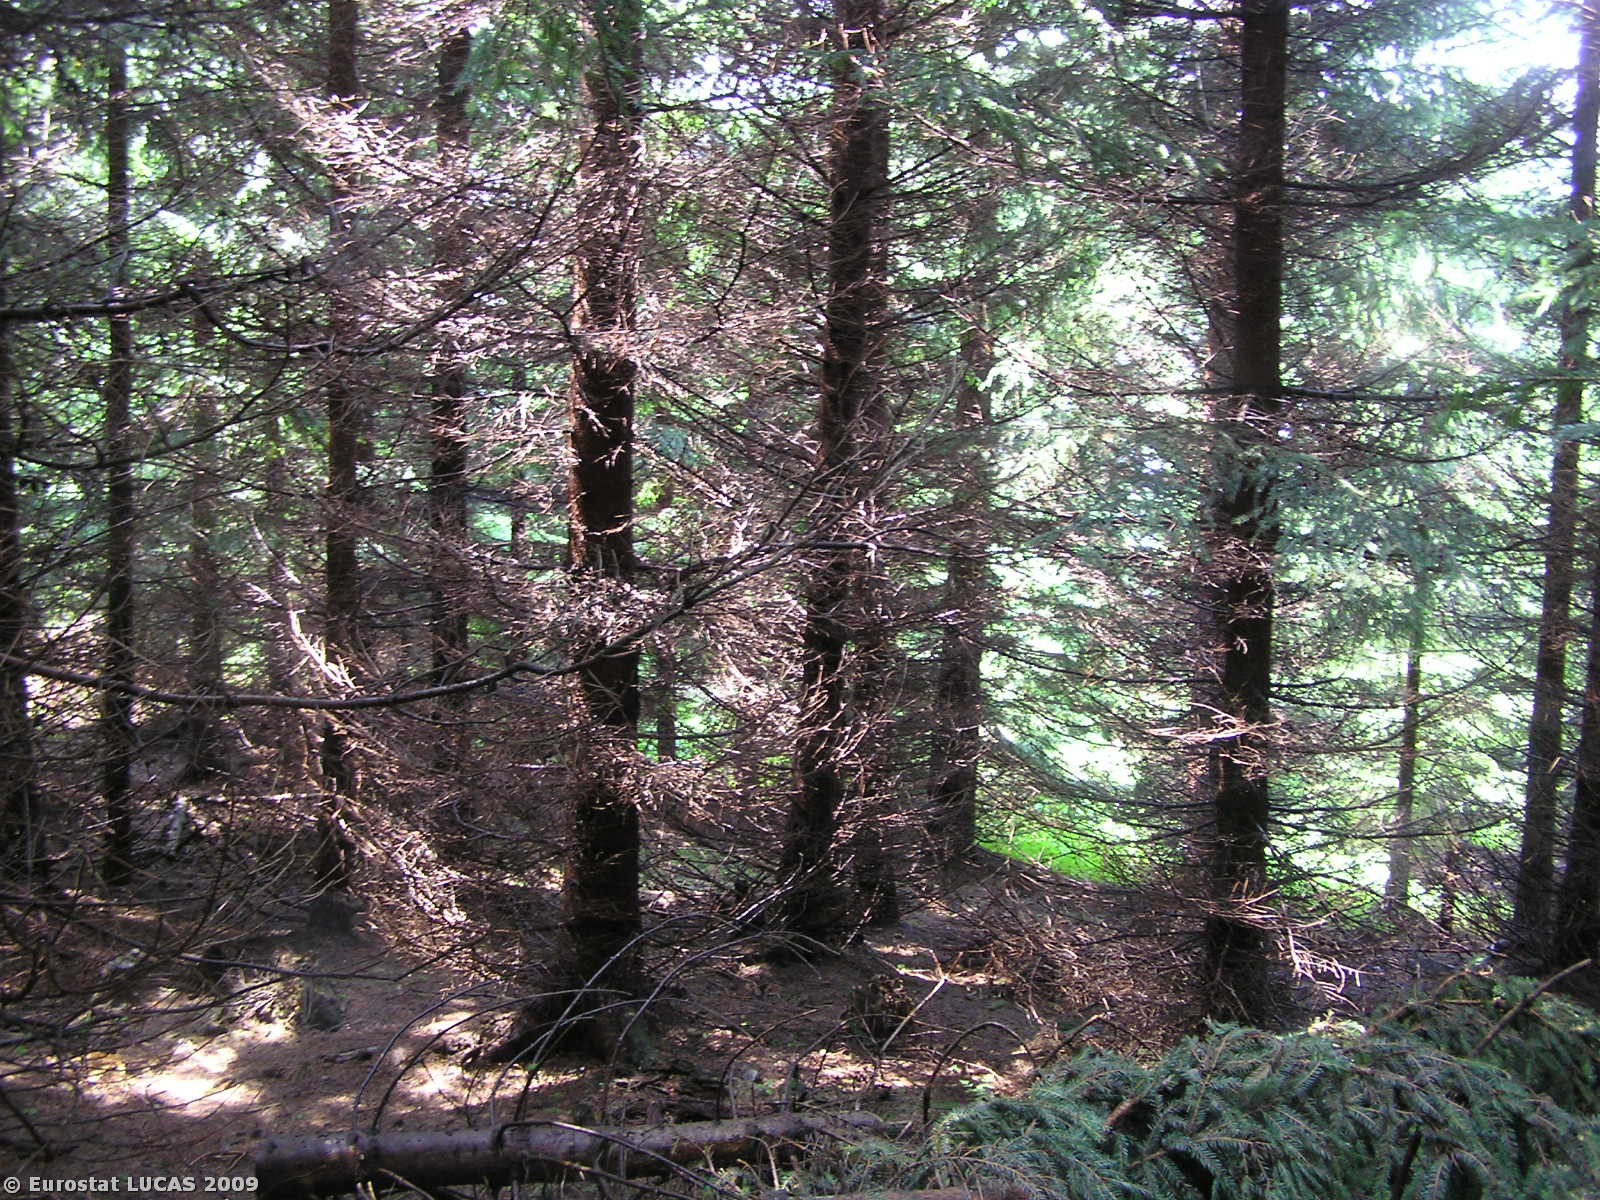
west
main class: Woodland
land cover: Coniferous woodland
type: hemiboreal forest and nemoral coniferous forest and mixed broadleaved-coniferous forest
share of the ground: > 75 %
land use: Forestry
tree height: > 5 m
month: June
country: CZ
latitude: 50.2110
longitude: 17.4530
